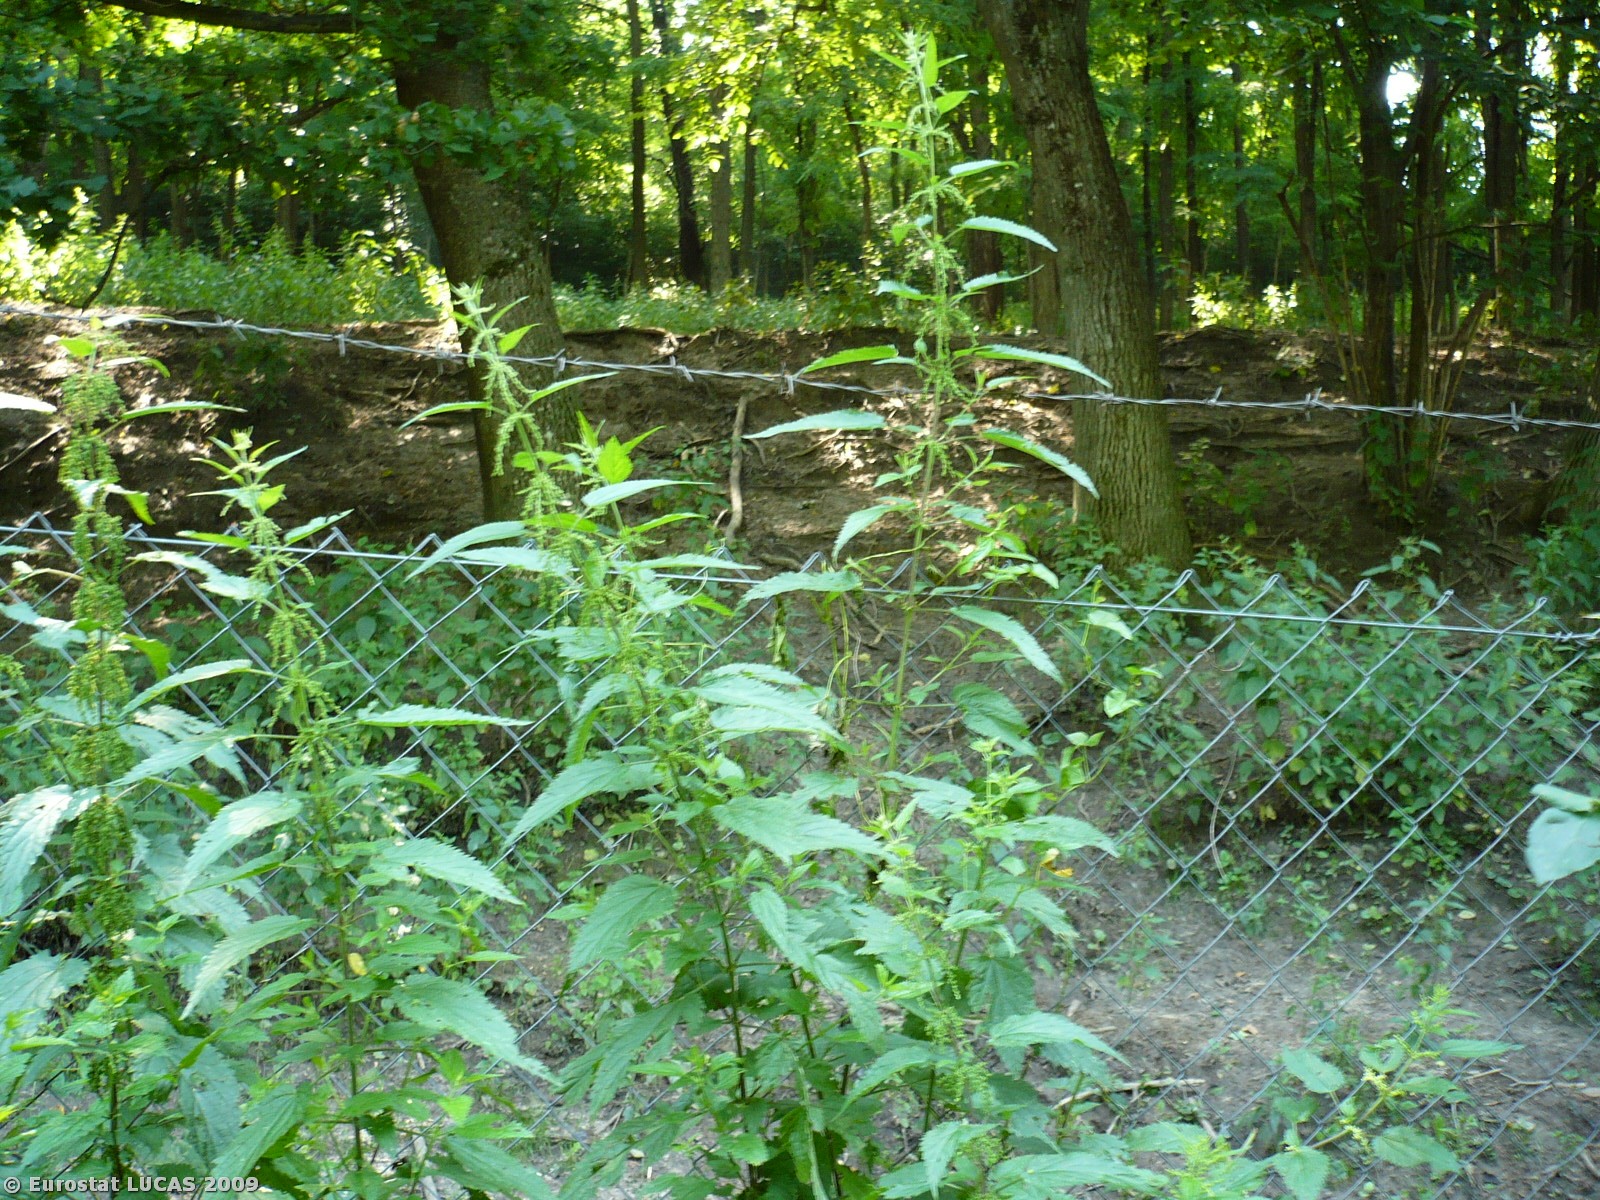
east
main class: Woodland
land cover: Broadleaved woodland
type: mesophytic deciduous forest
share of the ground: > 75 %
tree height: > 5 m
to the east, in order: Broadleaved woodland; Fences; Grass margins; Vineyards; Grass margins; Tracks; Broadleaved woodland
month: July
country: SI
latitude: 46.5503
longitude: 16.5094
